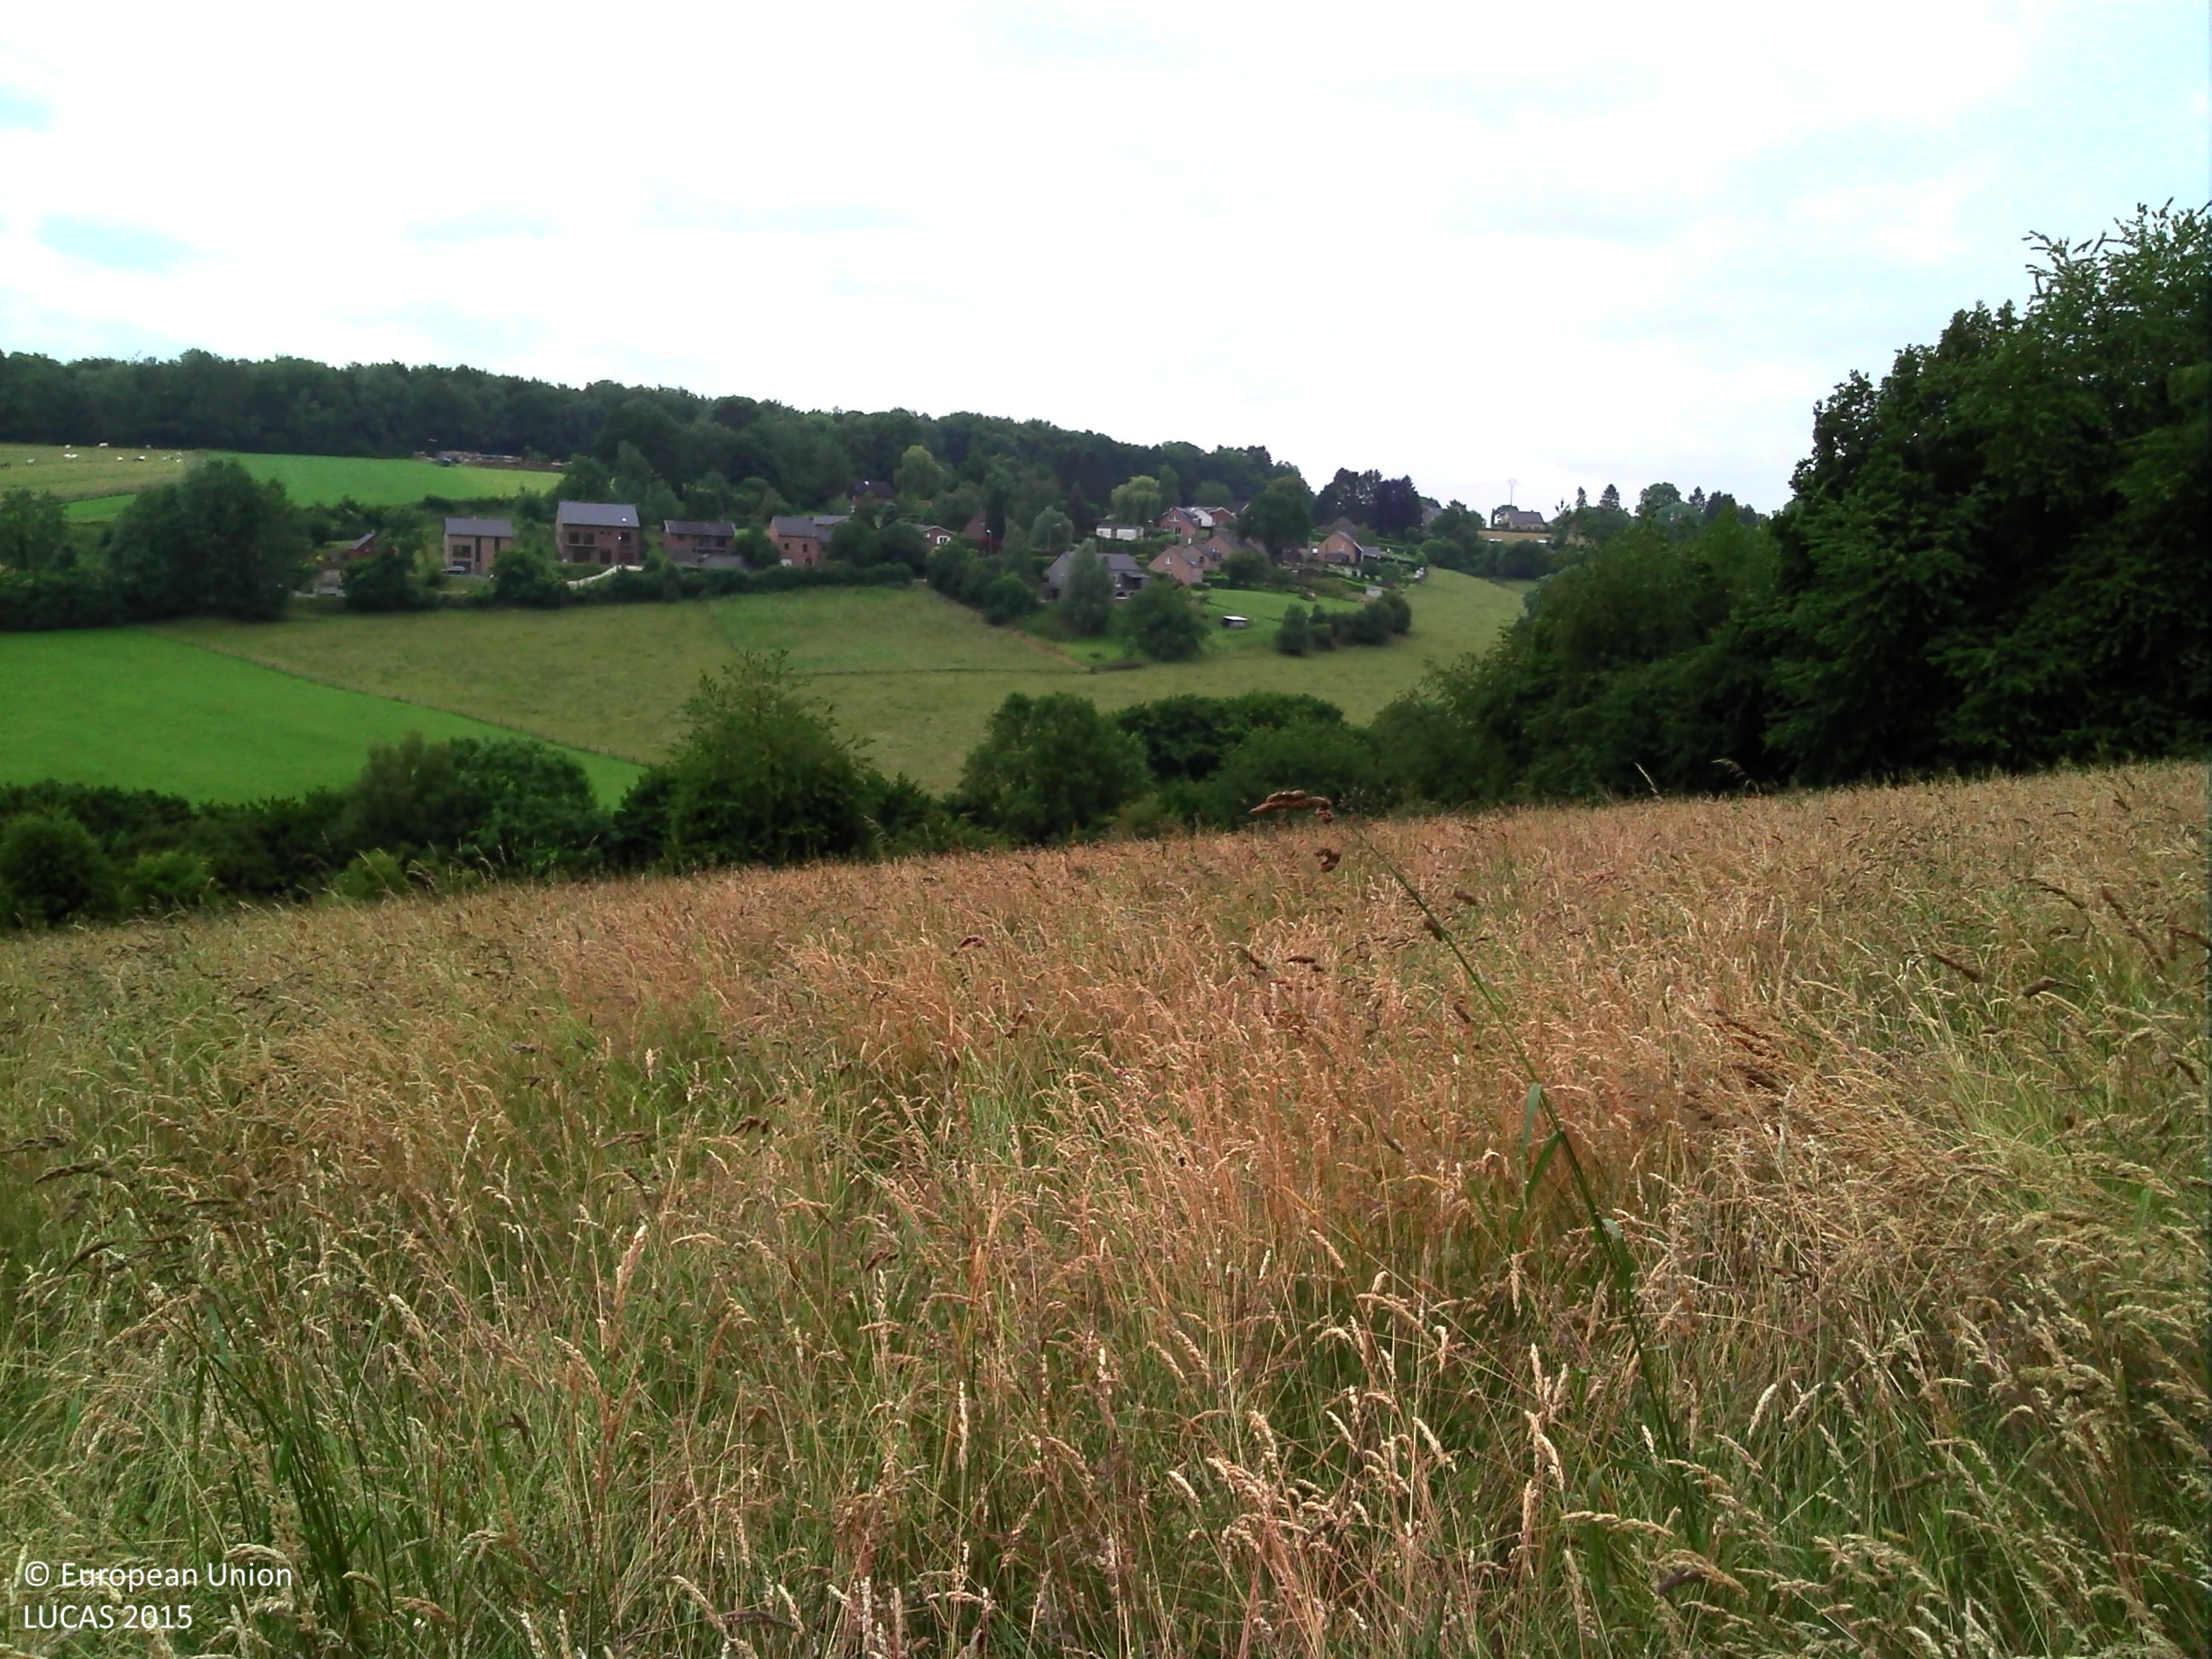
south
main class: Grassland
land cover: Grassland without tree/shrub cover
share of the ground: > 75 %
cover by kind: herbaceous plants 100 %
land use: Agriculture (excluding fallow land and kitchen gardens)
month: June
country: BE
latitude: 50.4928
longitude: 5.5298
